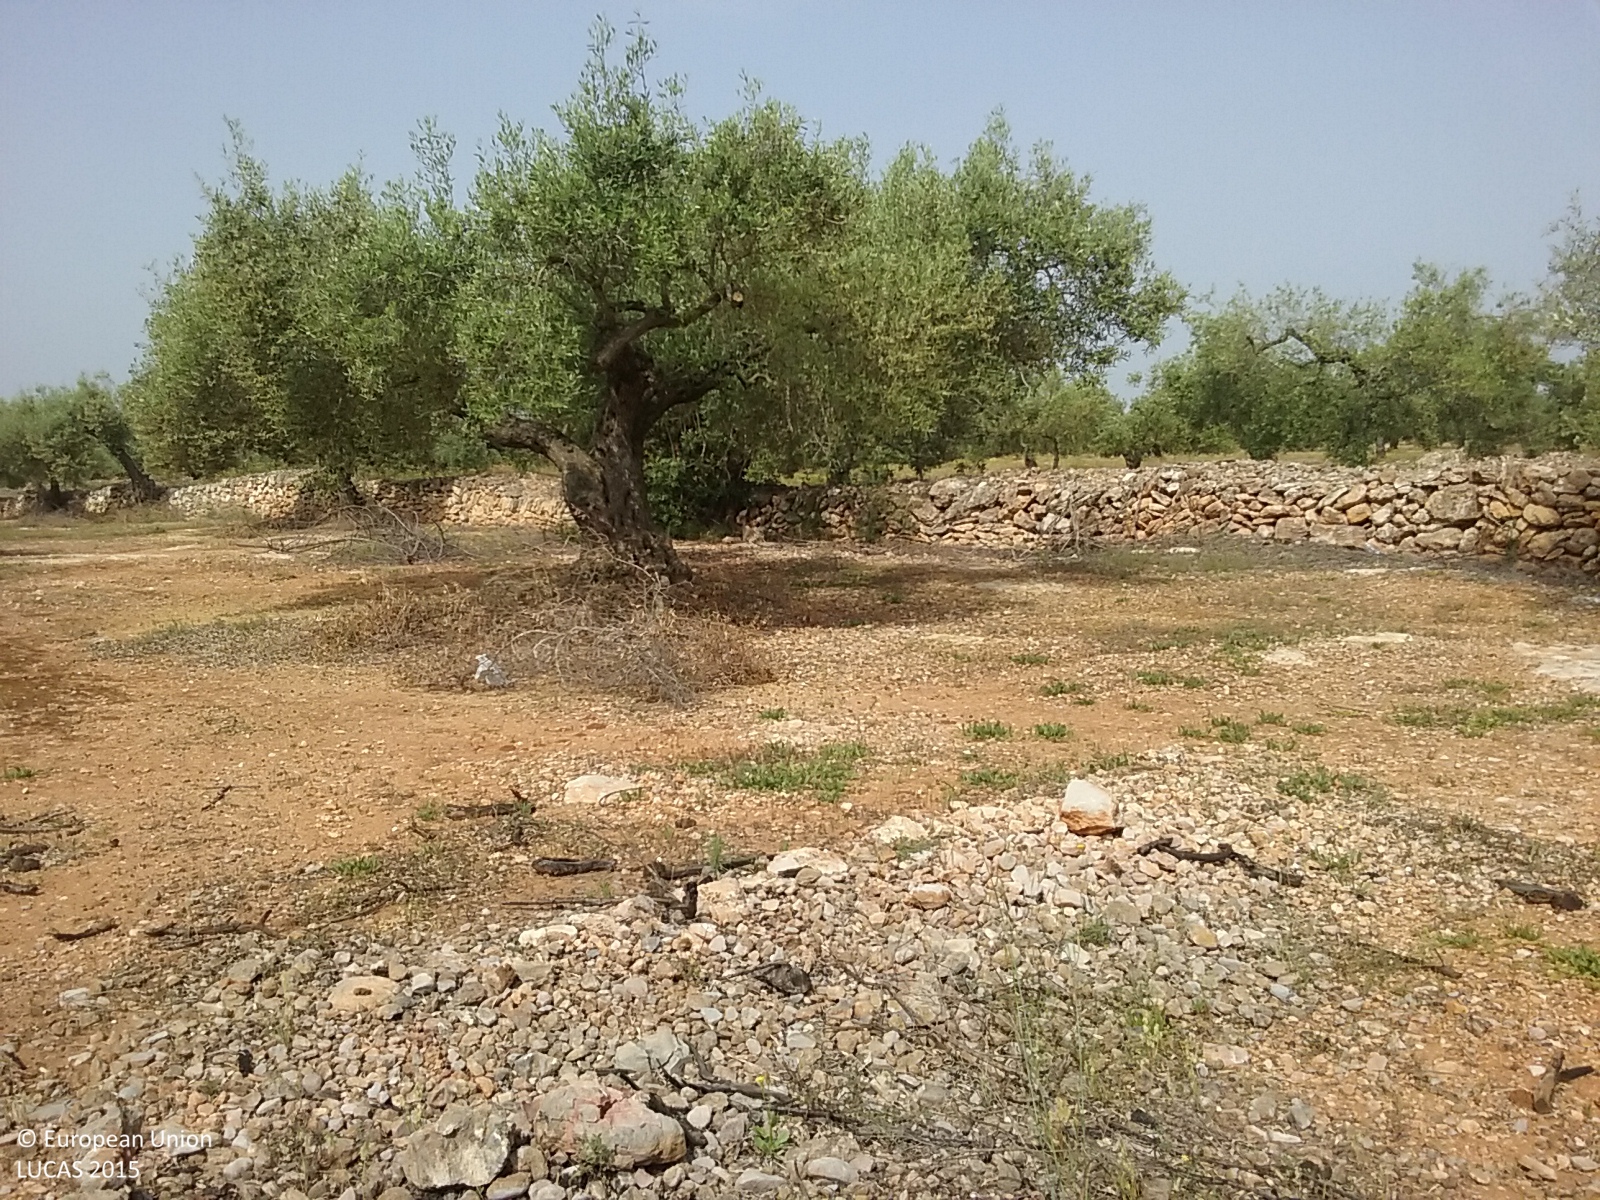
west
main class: Cropland
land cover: Olive groves
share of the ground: 25 - 50 %
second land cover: Spontaneously vegetated surfaces
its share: 25 - 50 %
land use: Agriculture (excluding fallow land and kitchen gardens)
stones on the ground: 25 - 50 %
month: May
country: ES
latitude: 40.7638
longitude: 0.6242
